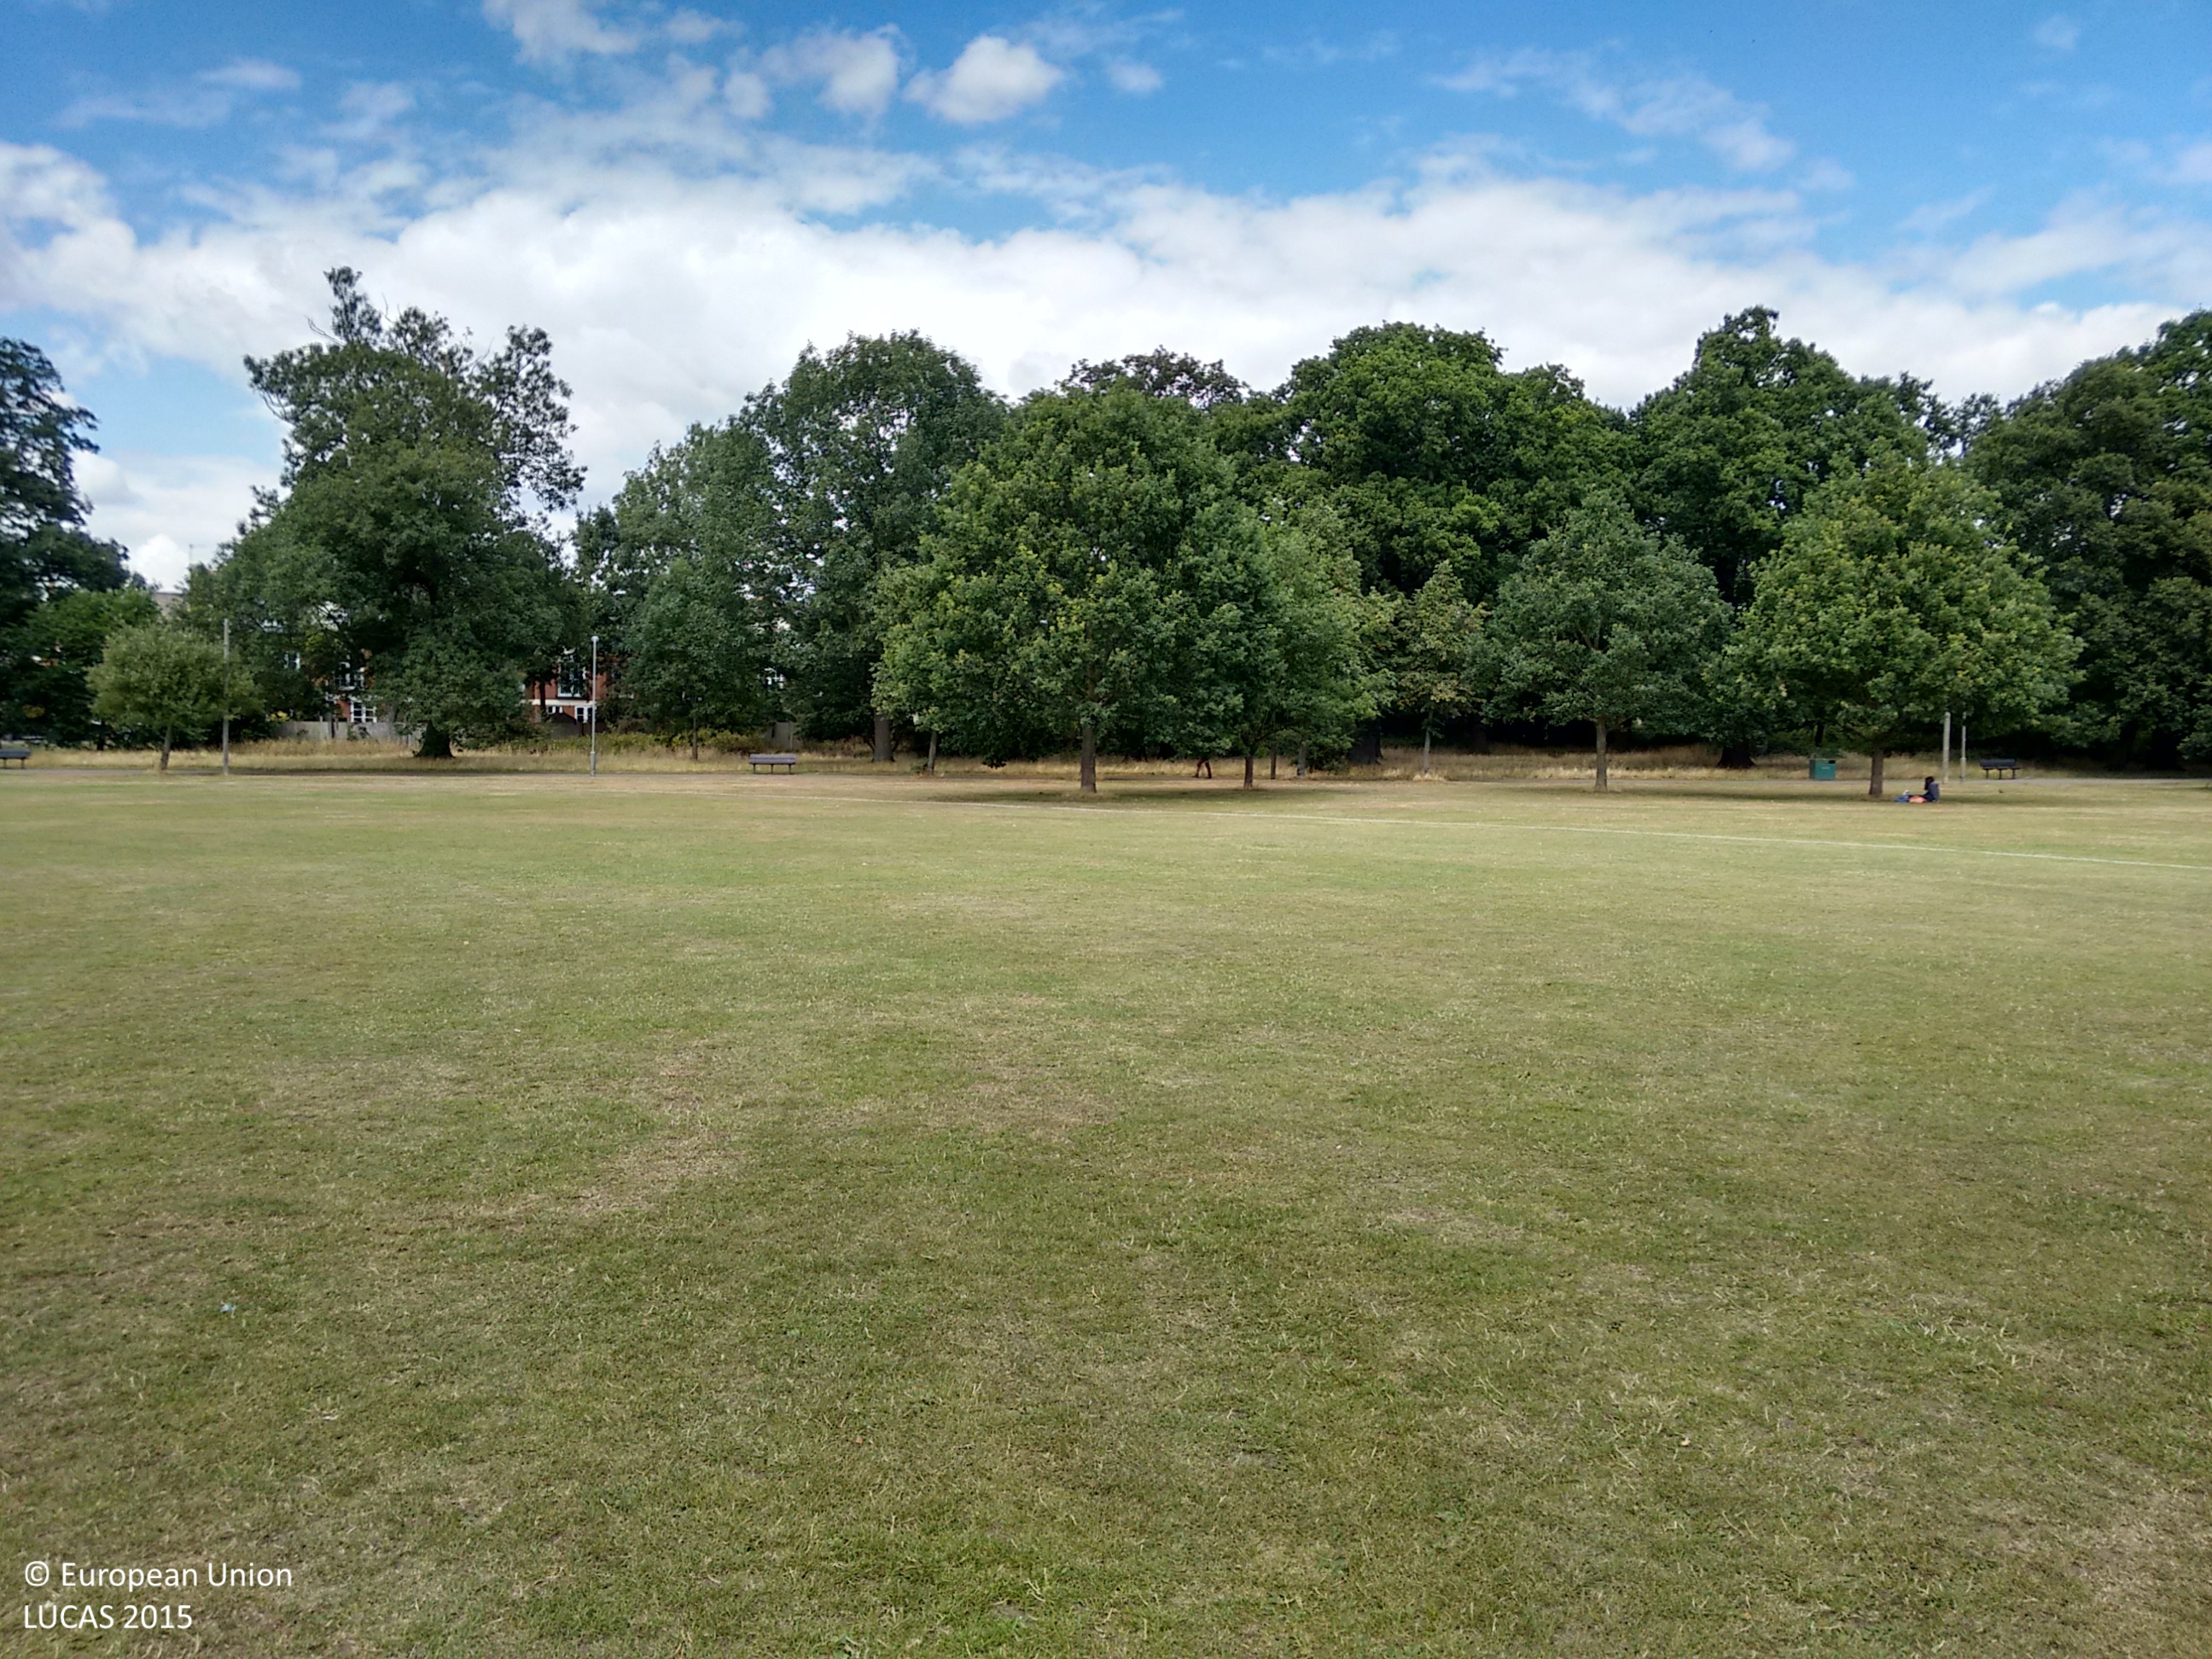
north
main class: Grassland
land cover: Grassland without tree/shrub cover
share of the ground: > 75 %
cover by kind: herbaceous plants 100 %
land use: Amenities, museums, leisure
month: July
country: GB
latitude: 51.4341
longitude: -0.1469
